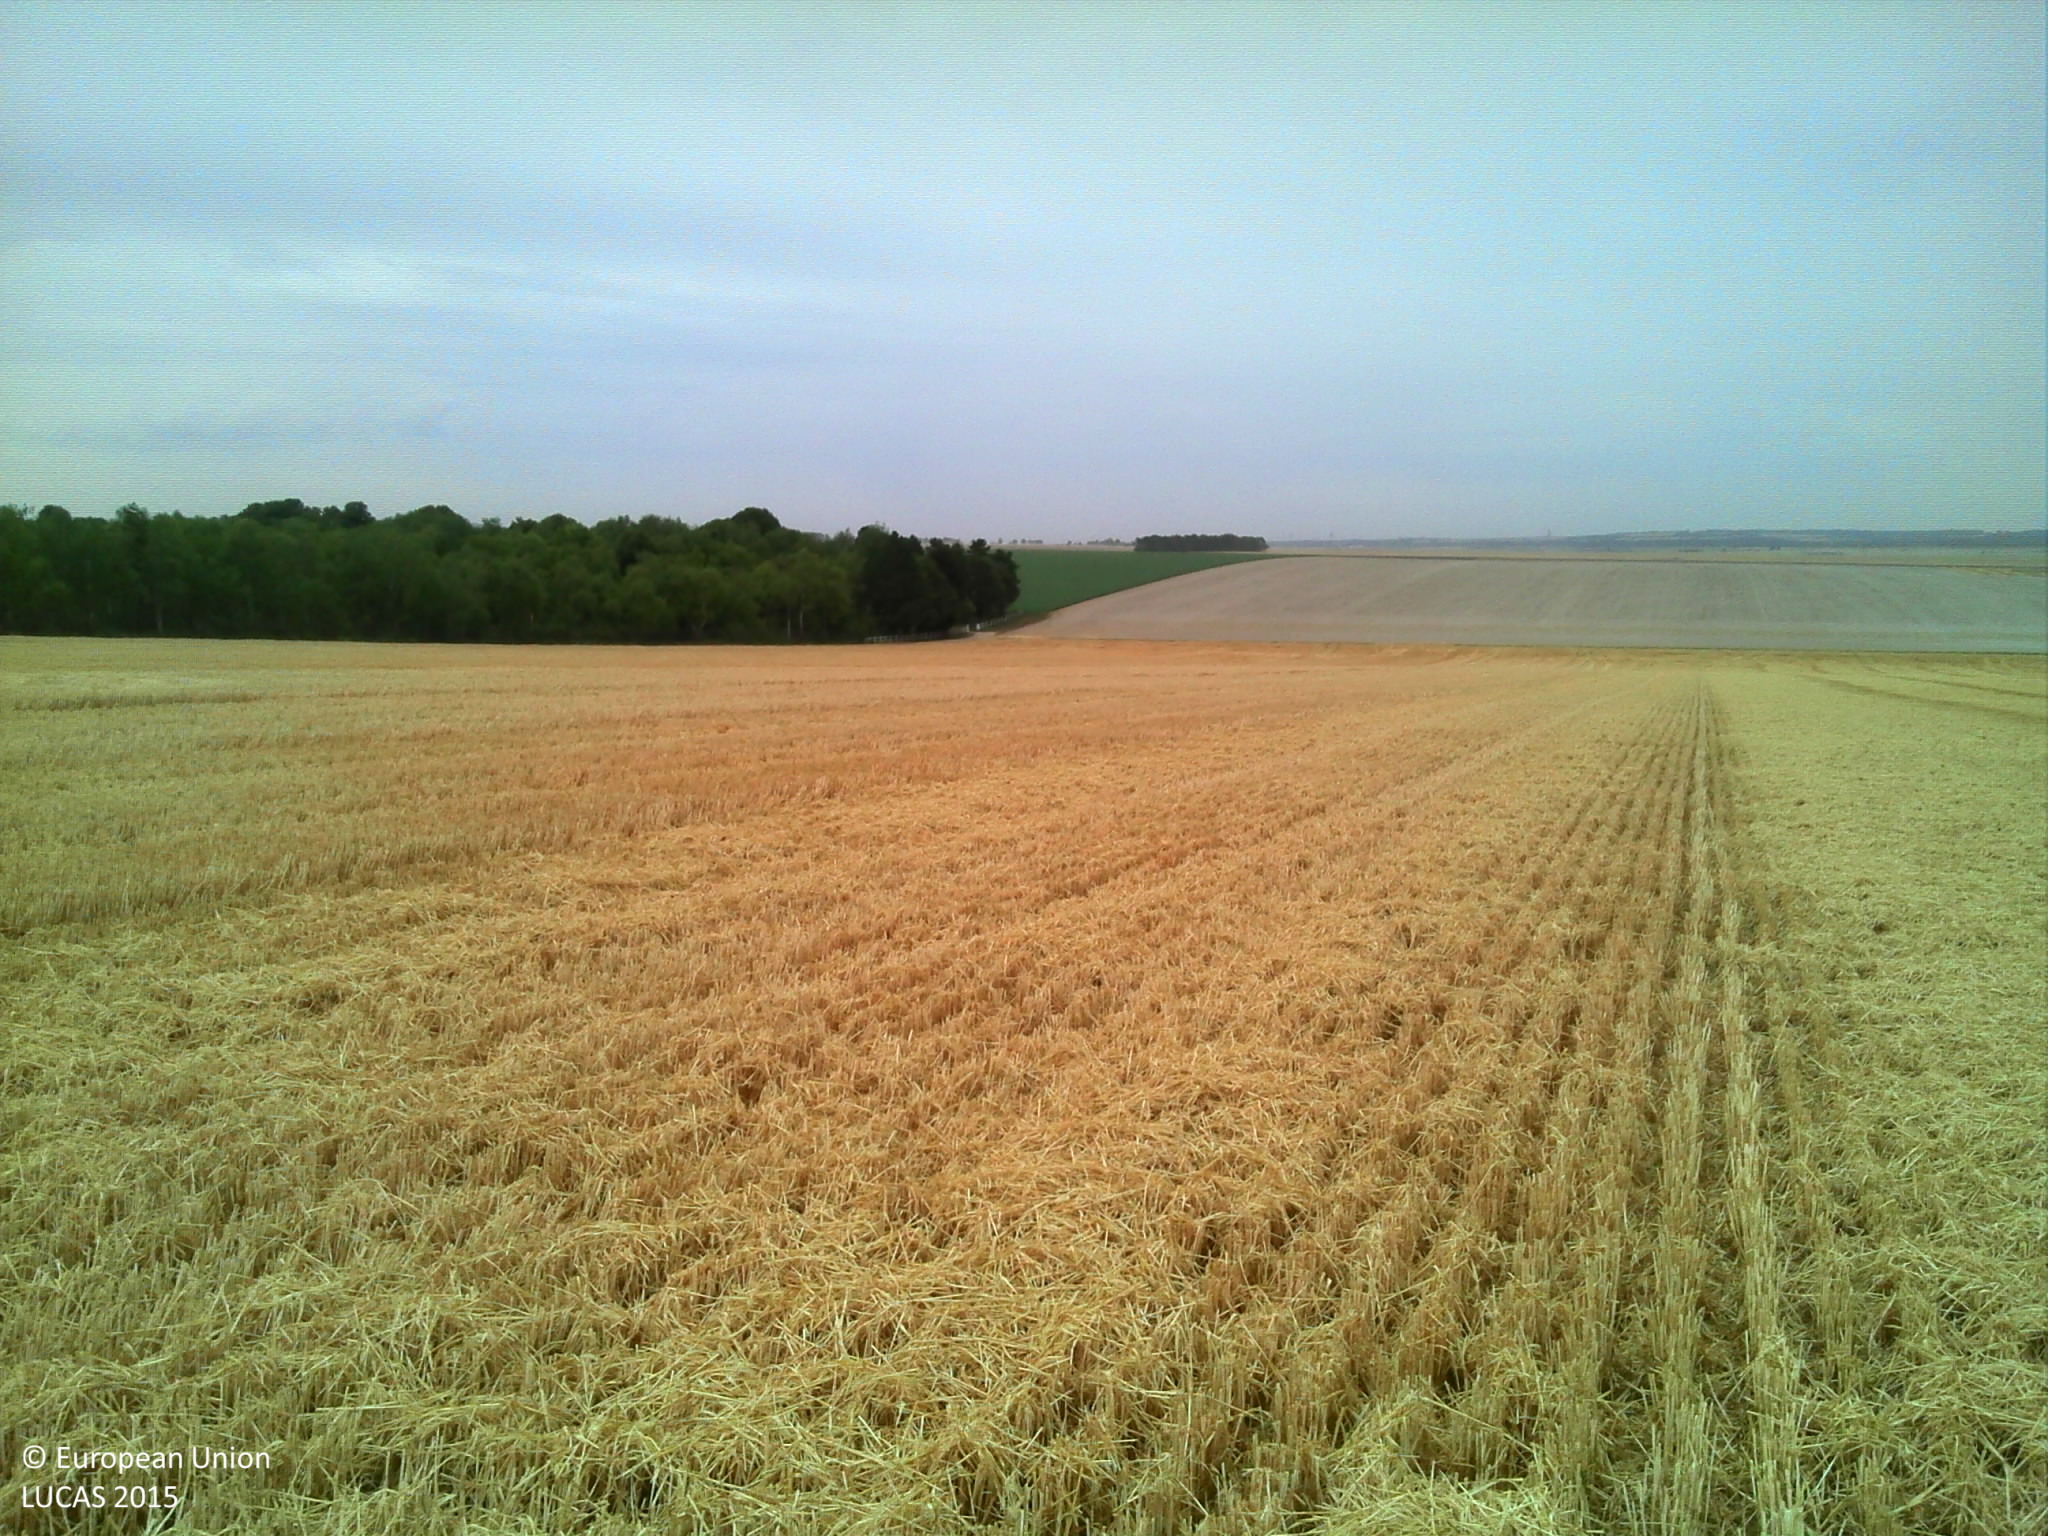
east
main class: Cropland
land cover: Rye
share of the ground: > 75 %
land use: Agriculture (excluding fallow land and kitchen gardens)
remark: Harvested field
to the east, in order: Rye; Grass margins; Tracks; Grass margins; Fences; Broadleaved woodland
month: July
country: FR
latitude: 49.2246
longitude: 4.1874
